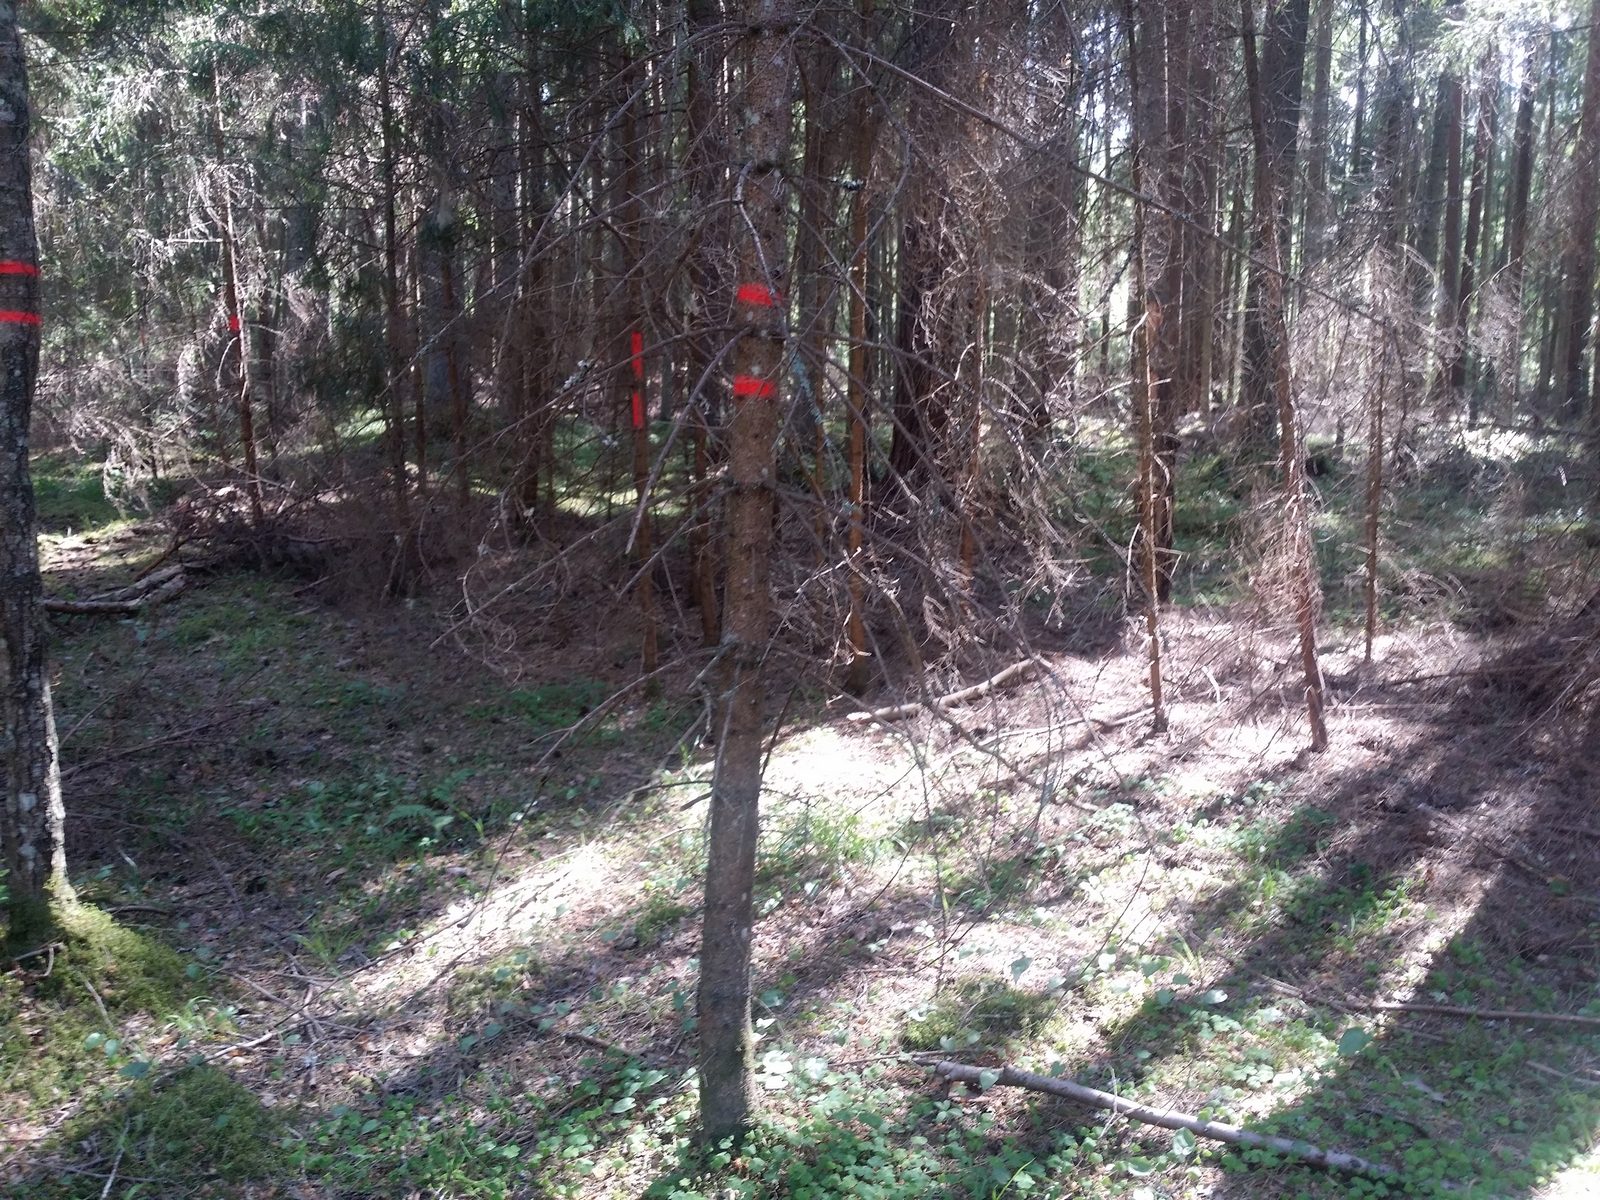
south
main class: Woodland
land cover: Spruce dominated coniferous woodland
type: hemiboreal forest and nemoral coniferous forest and mixed broadleaved-coniferous forest
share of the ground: > 75 %
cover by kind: coniferous forest trees 75 %, lichens and mosses 15 %, herbaceous plants 10 %
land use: Forestry
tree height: > 5 m
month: June
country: LV
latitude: 57.3258
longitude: 26.4343
